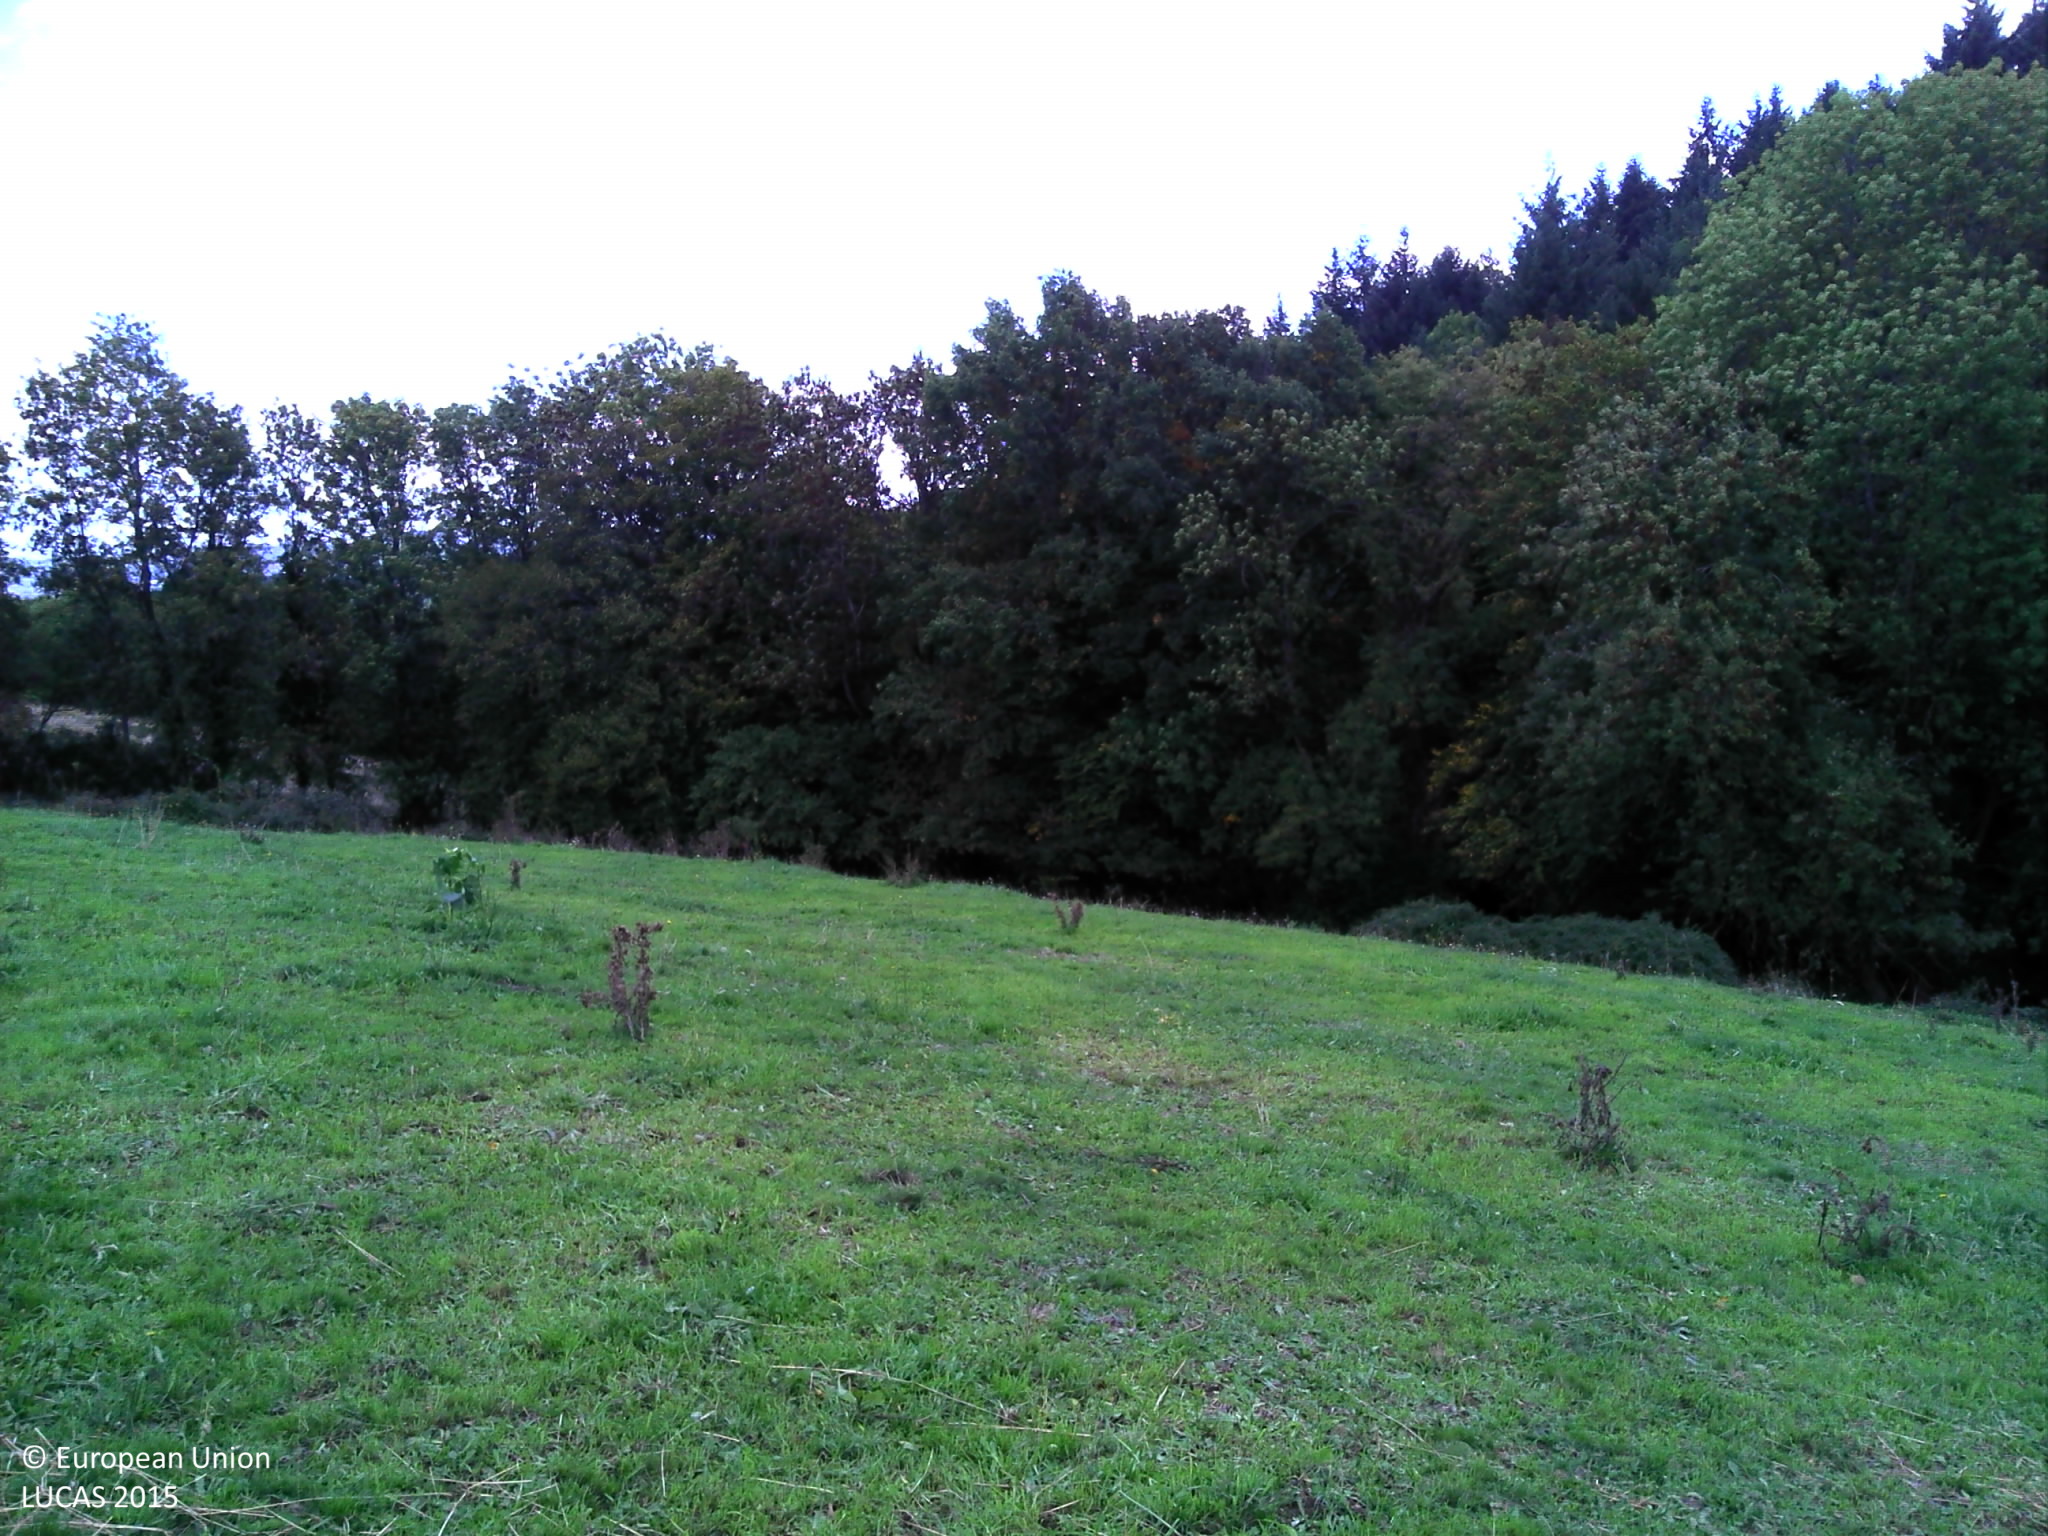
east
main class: Grassland
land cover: Grassland without tree/shrub cover
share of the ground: > 75 %
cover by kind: herbaceous plants 100 %
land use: Agriculture (excluding fallow land and kitchen gardens)
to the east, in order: Grassland without tree/shrub cover; Broadleaved woodland; Spontaneously vegetated surfaces; Ditches and canals; Dry stone walls; Broadleaved woodland; Fences; Broadleaved woodland; Shrubland without tree cover; Broadleaved woodland; Fences; Broadleaved woodland
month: October
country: FR
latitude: 46.0857
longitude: 3.0020
